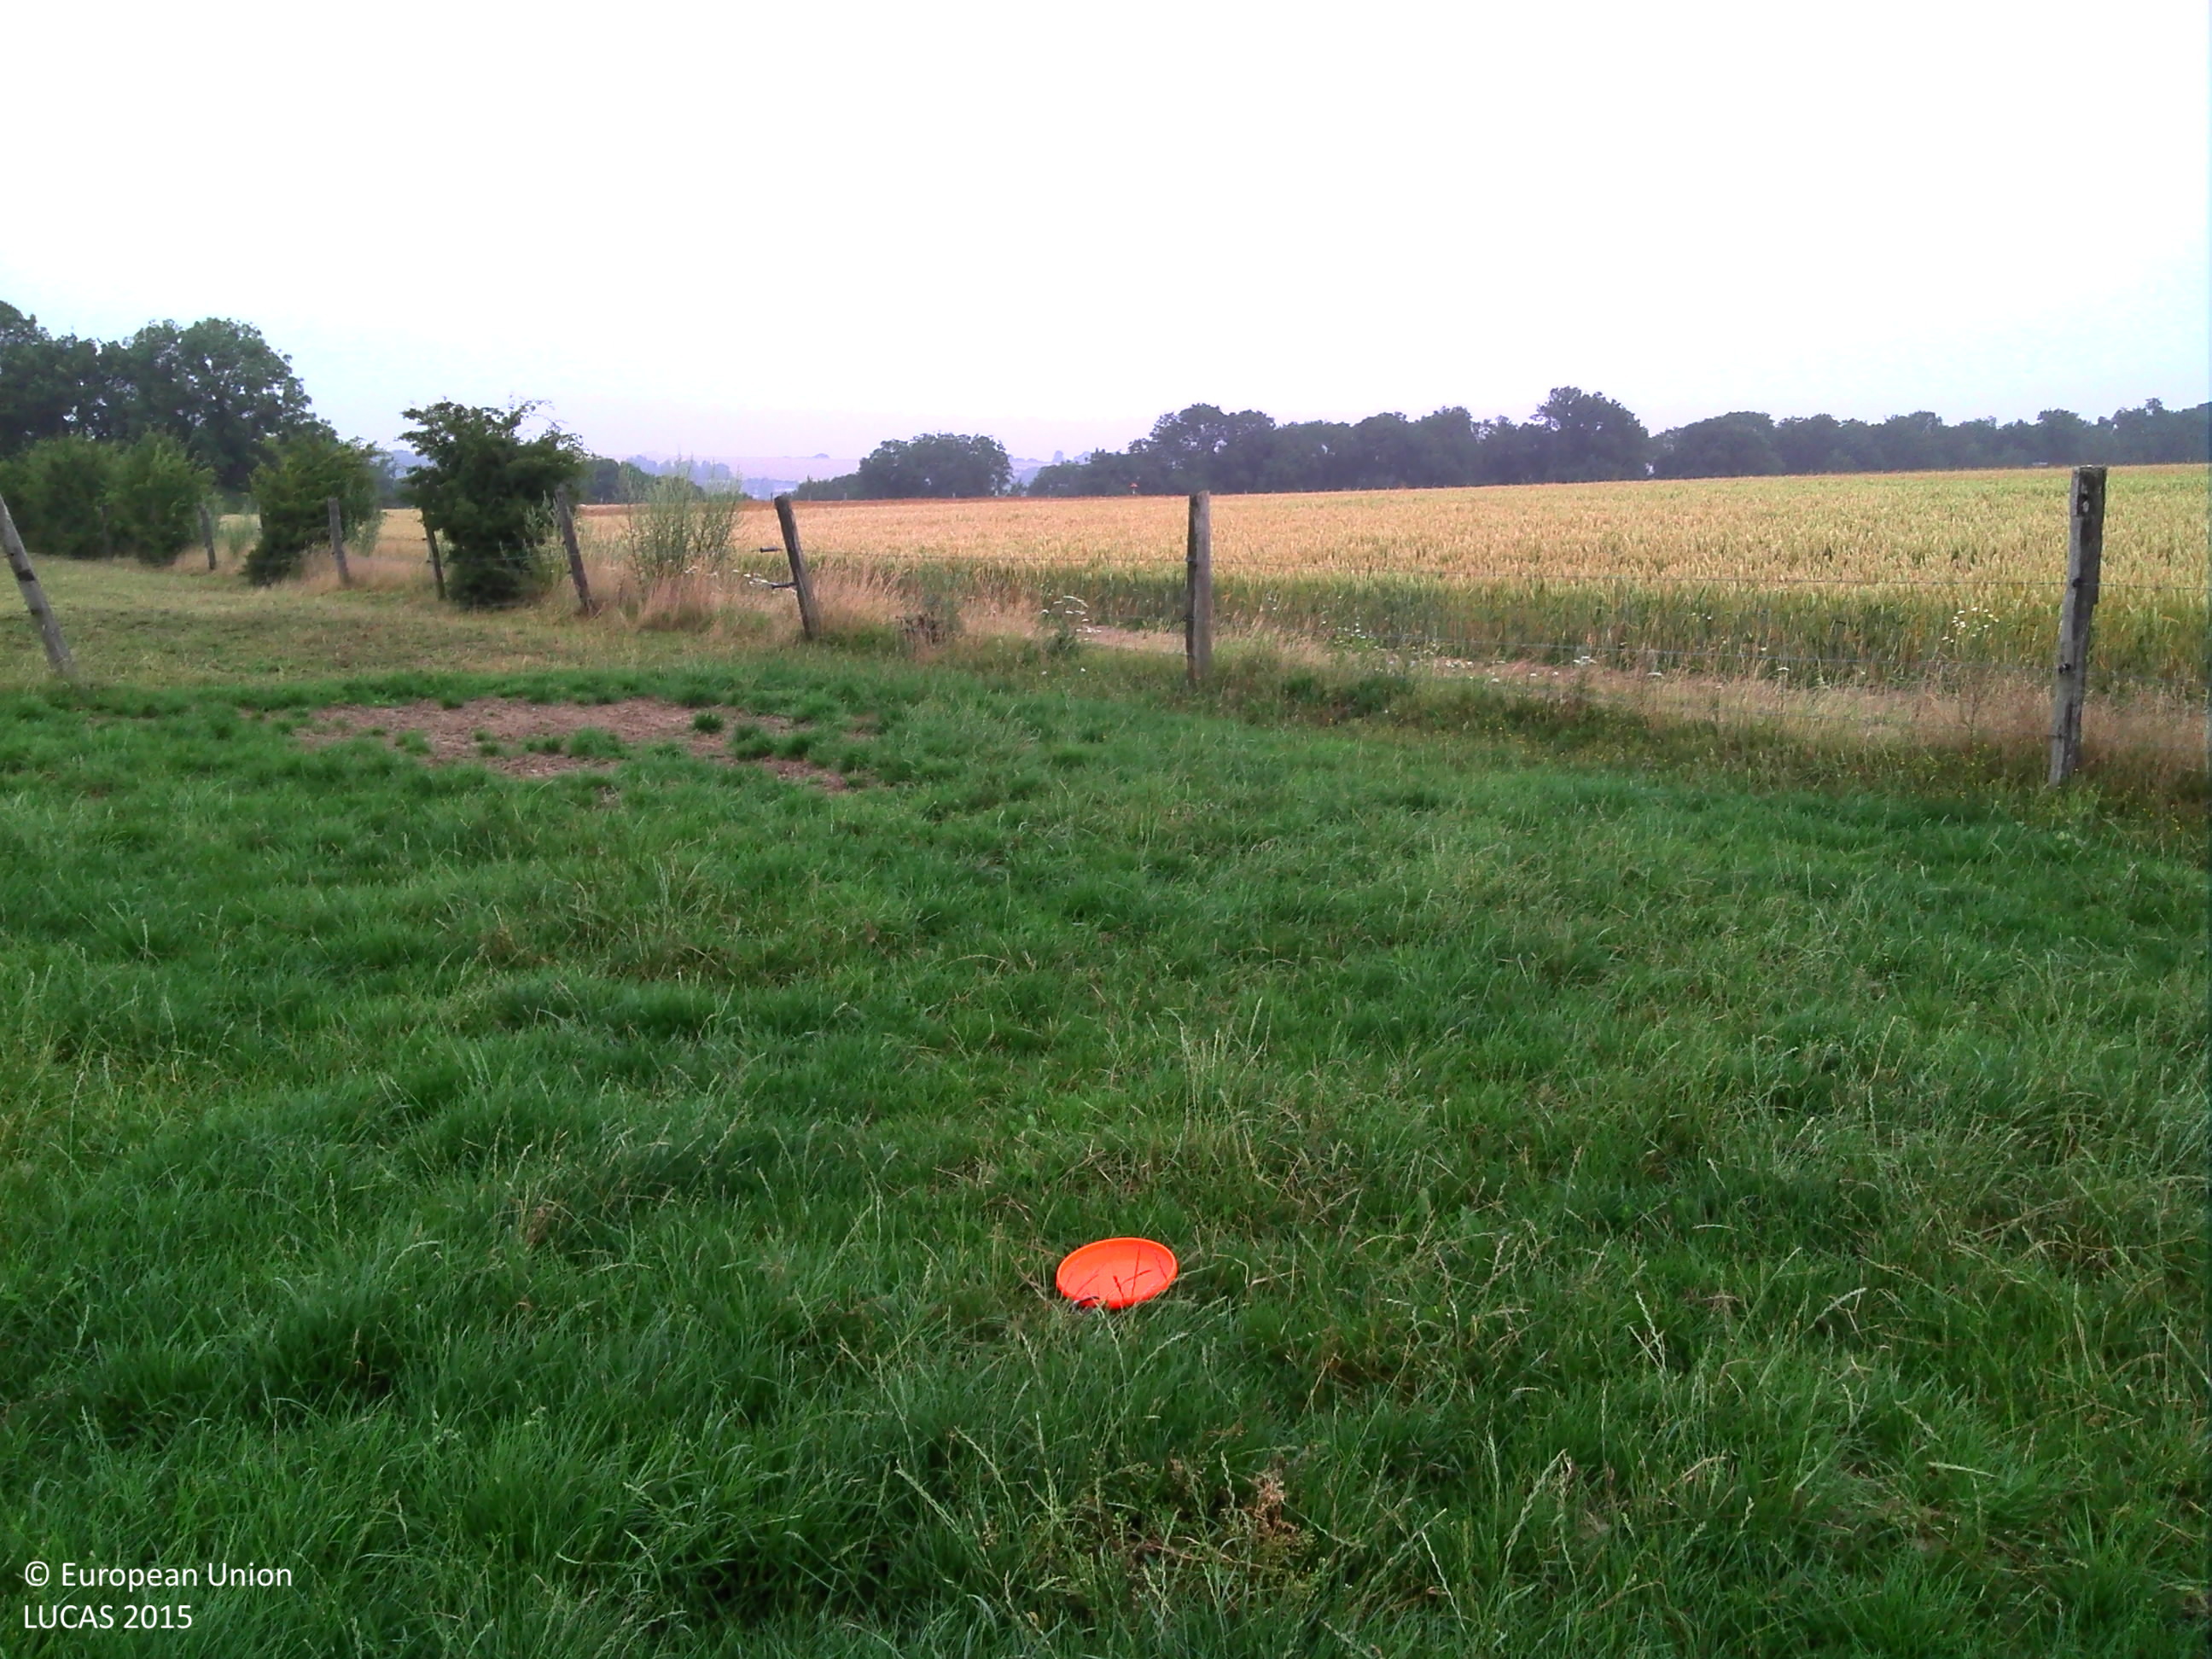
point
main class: Grassland
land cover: Grassland without tree/shrub cover
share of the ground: > 75 %
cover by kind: herbaceous plants 100 %
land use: Agriculture (excluding fallow land and kitchen gardens)
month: July
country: BE
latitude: 50.7473
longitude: 5.5906
